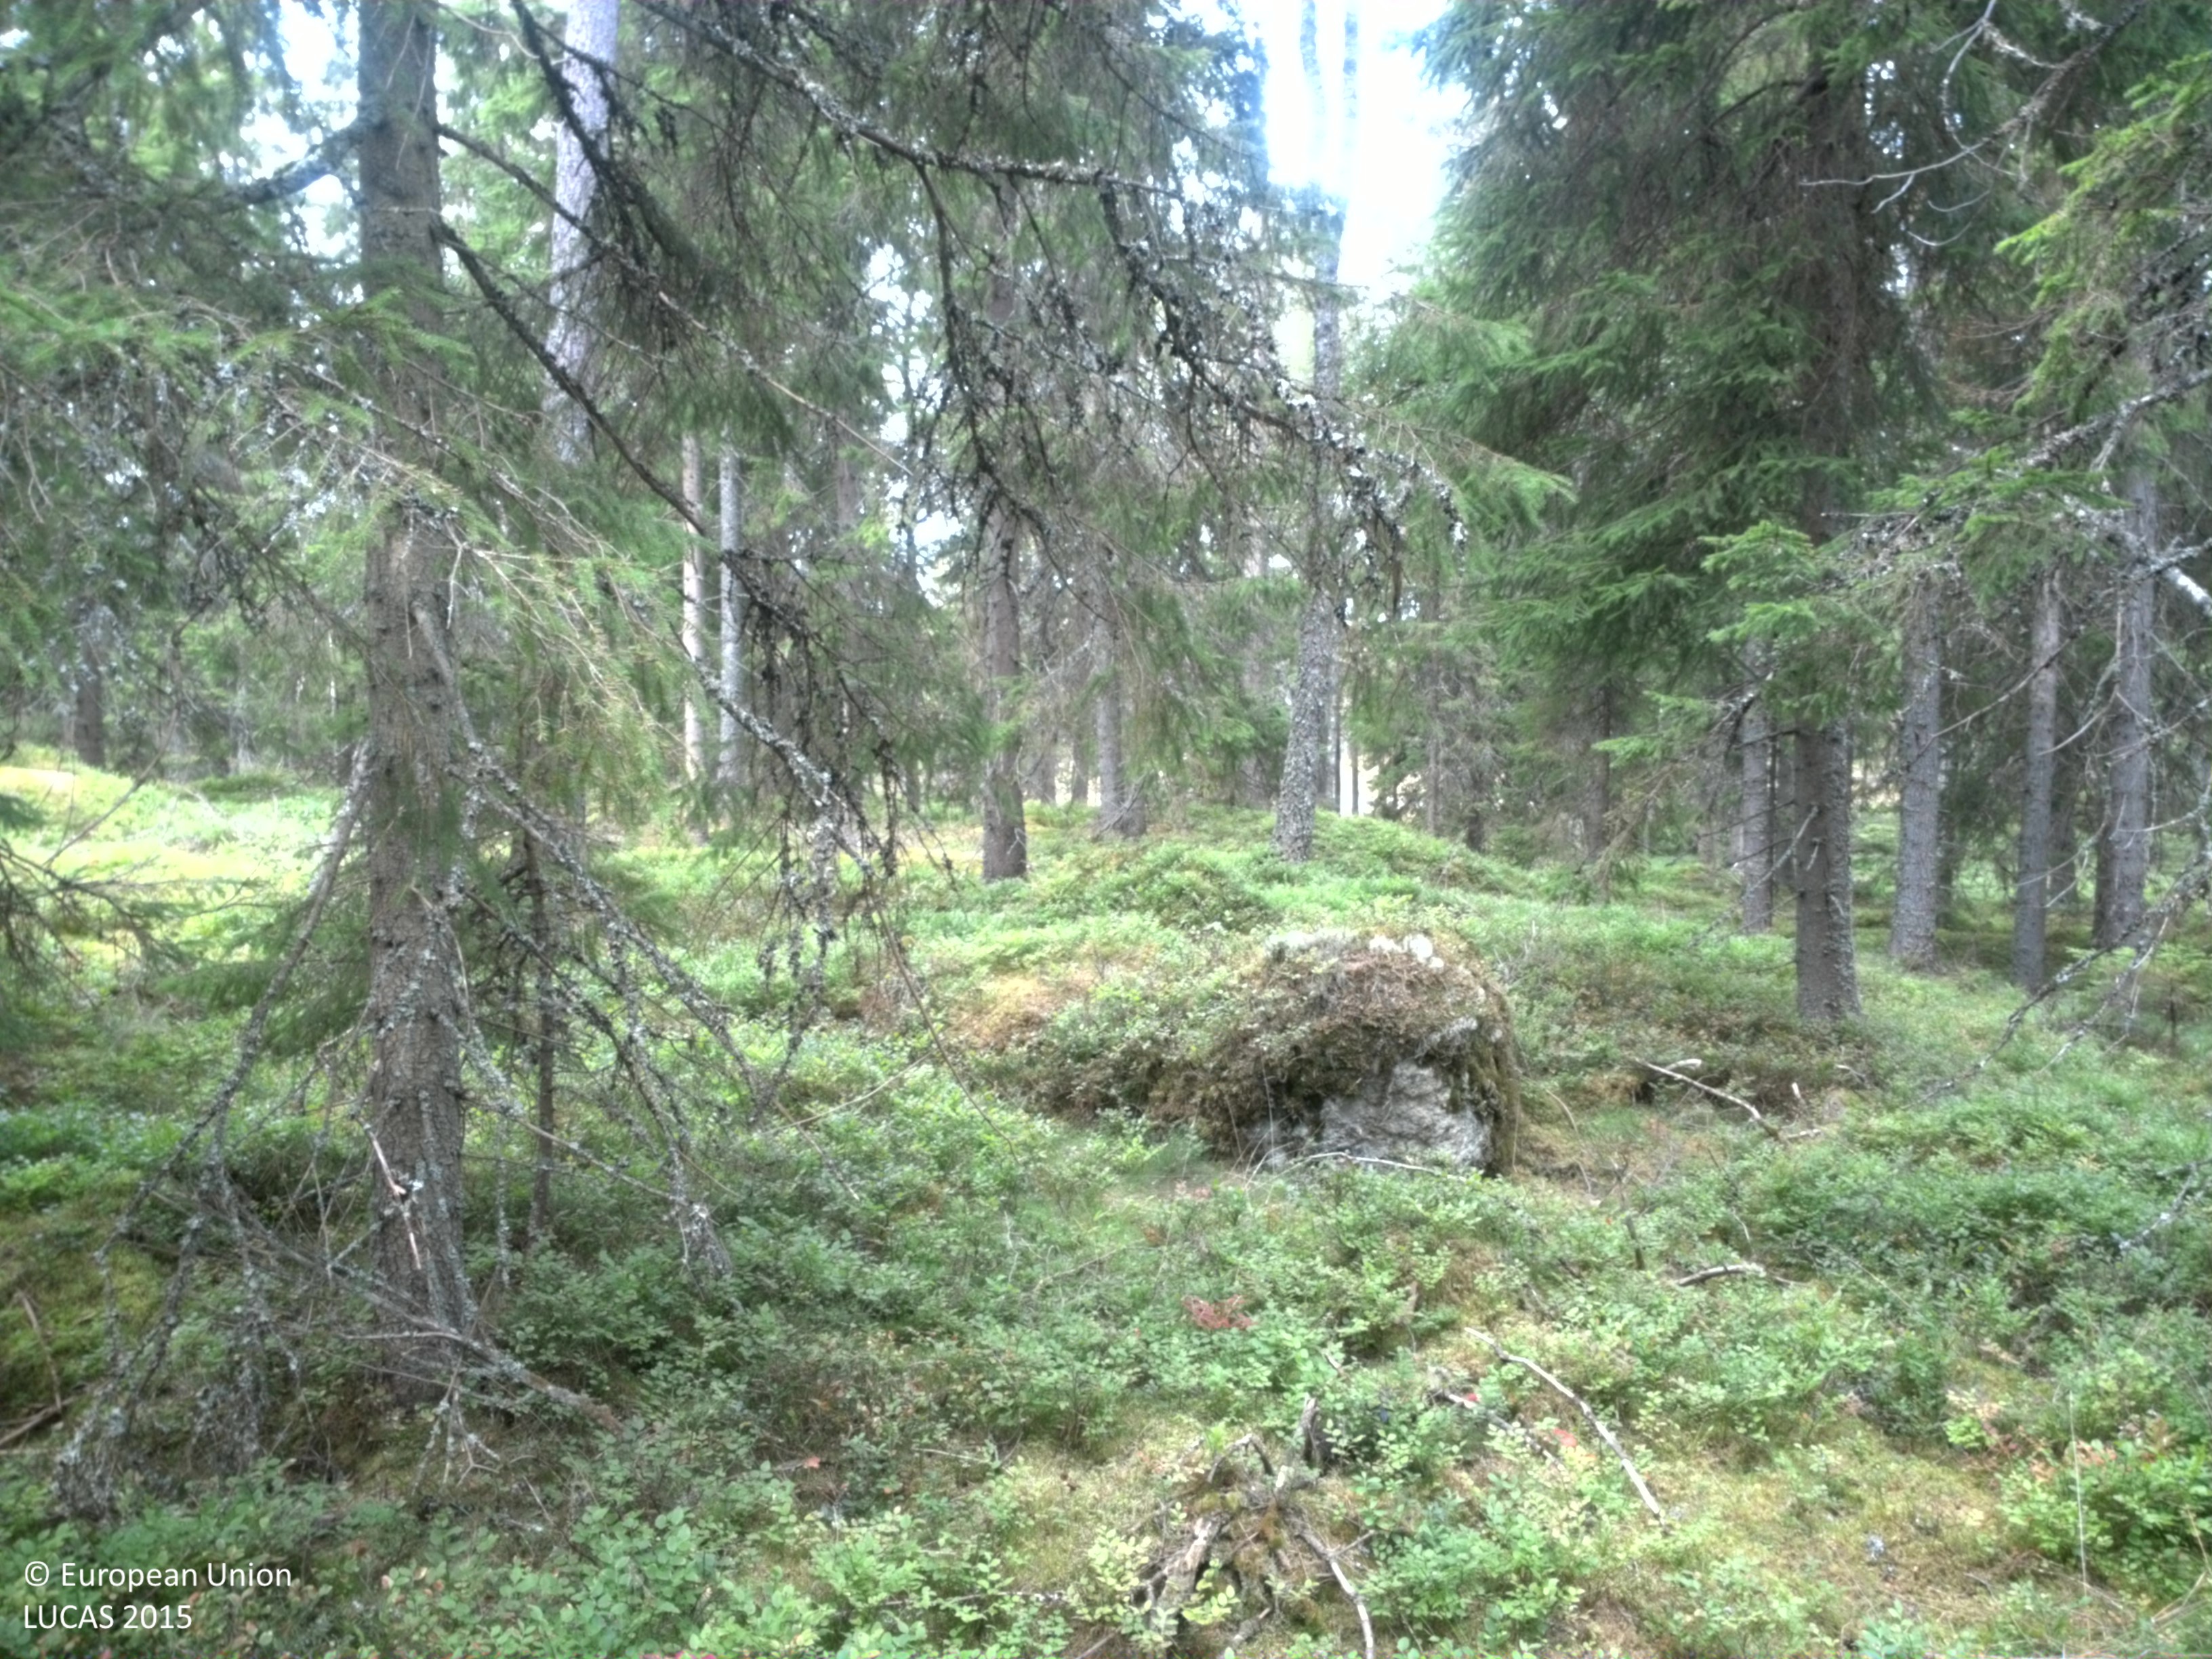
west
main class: Woodland
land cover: Spruce dominated coniferous woodland
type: boreal forest
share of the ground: 50 - 75 %
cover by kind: coniferous forest trees 55 %, shrubs 30 %, lichens and mosses 15 %
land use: Forestry
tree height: > 5 m
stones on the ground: 10 - 25 %
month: August
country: SE
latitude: 57.9829
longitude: 13.9011
